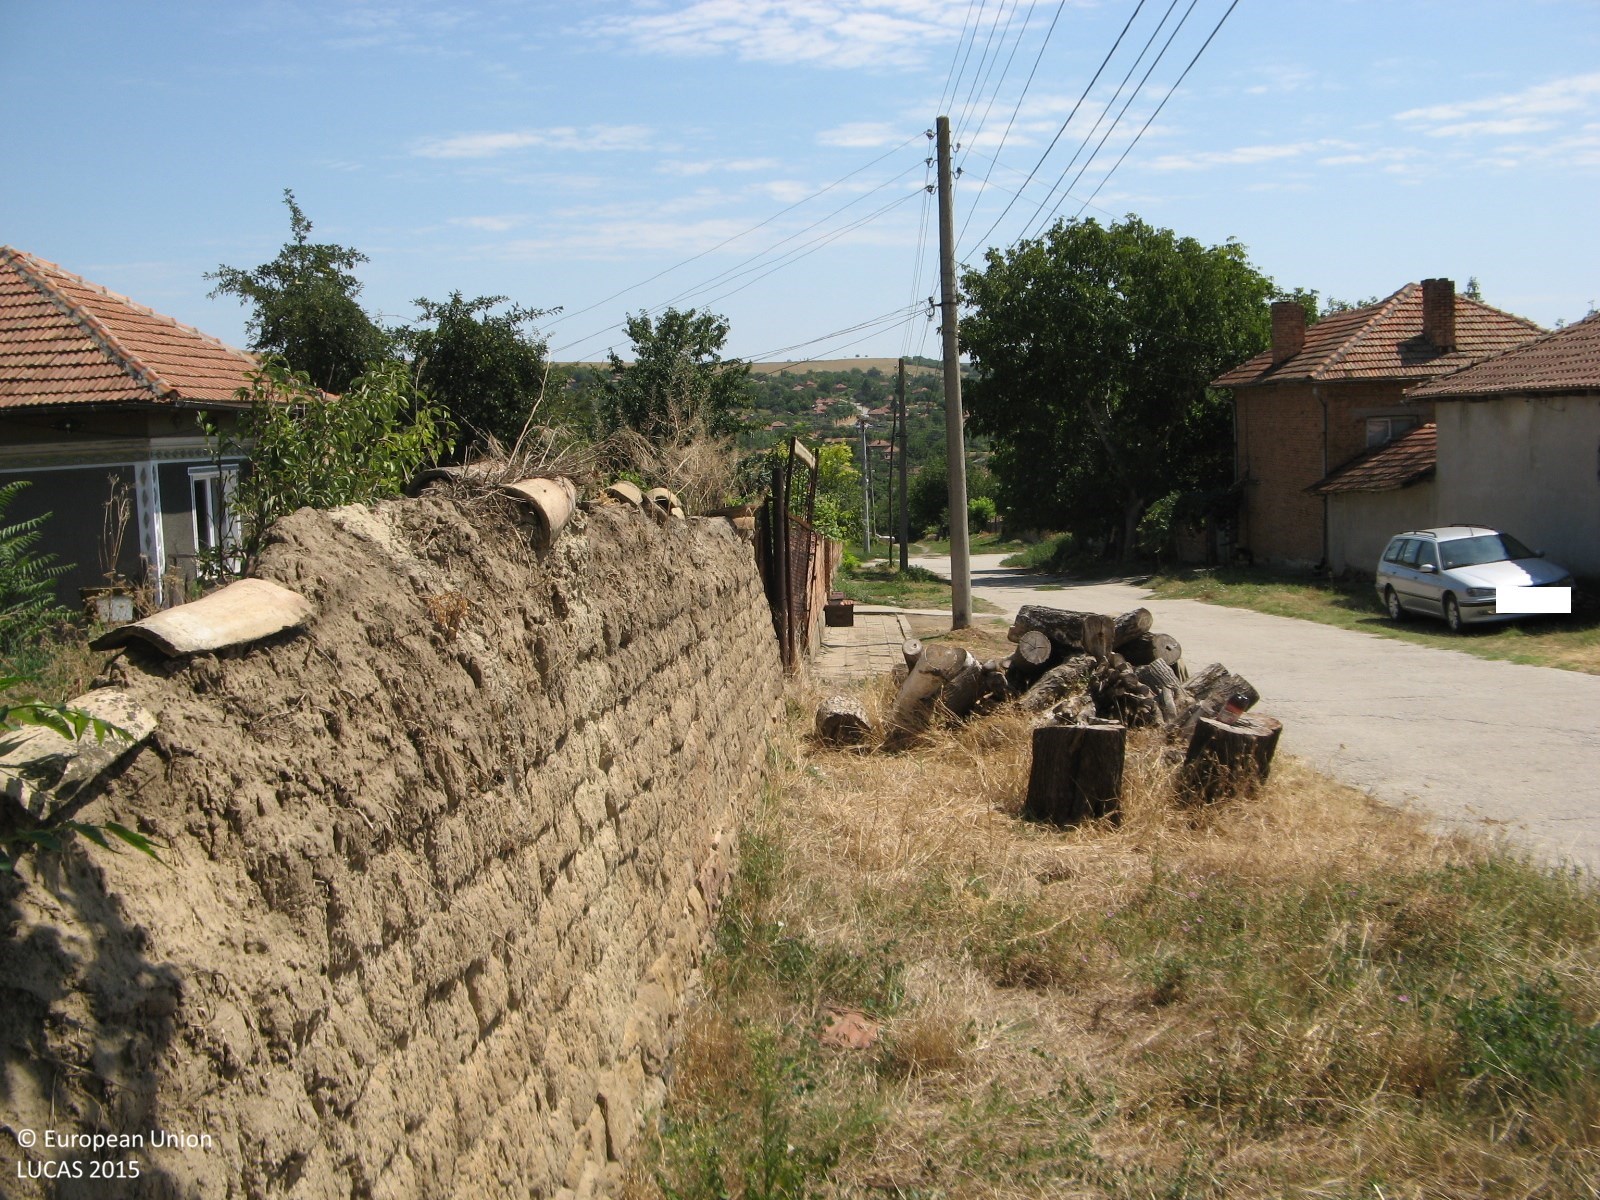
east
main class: Grassland
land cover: Spontaneously vegetated surfaces
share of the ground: > 75 %
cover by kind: herbaceous plants 95 %, shrubs 5 %
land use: Abandoned areas
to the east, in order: Spontaneously vegetated surfaces; Artificial constructions in urban areas
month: August
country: BG
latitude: 43.5112
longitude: 25.3553
